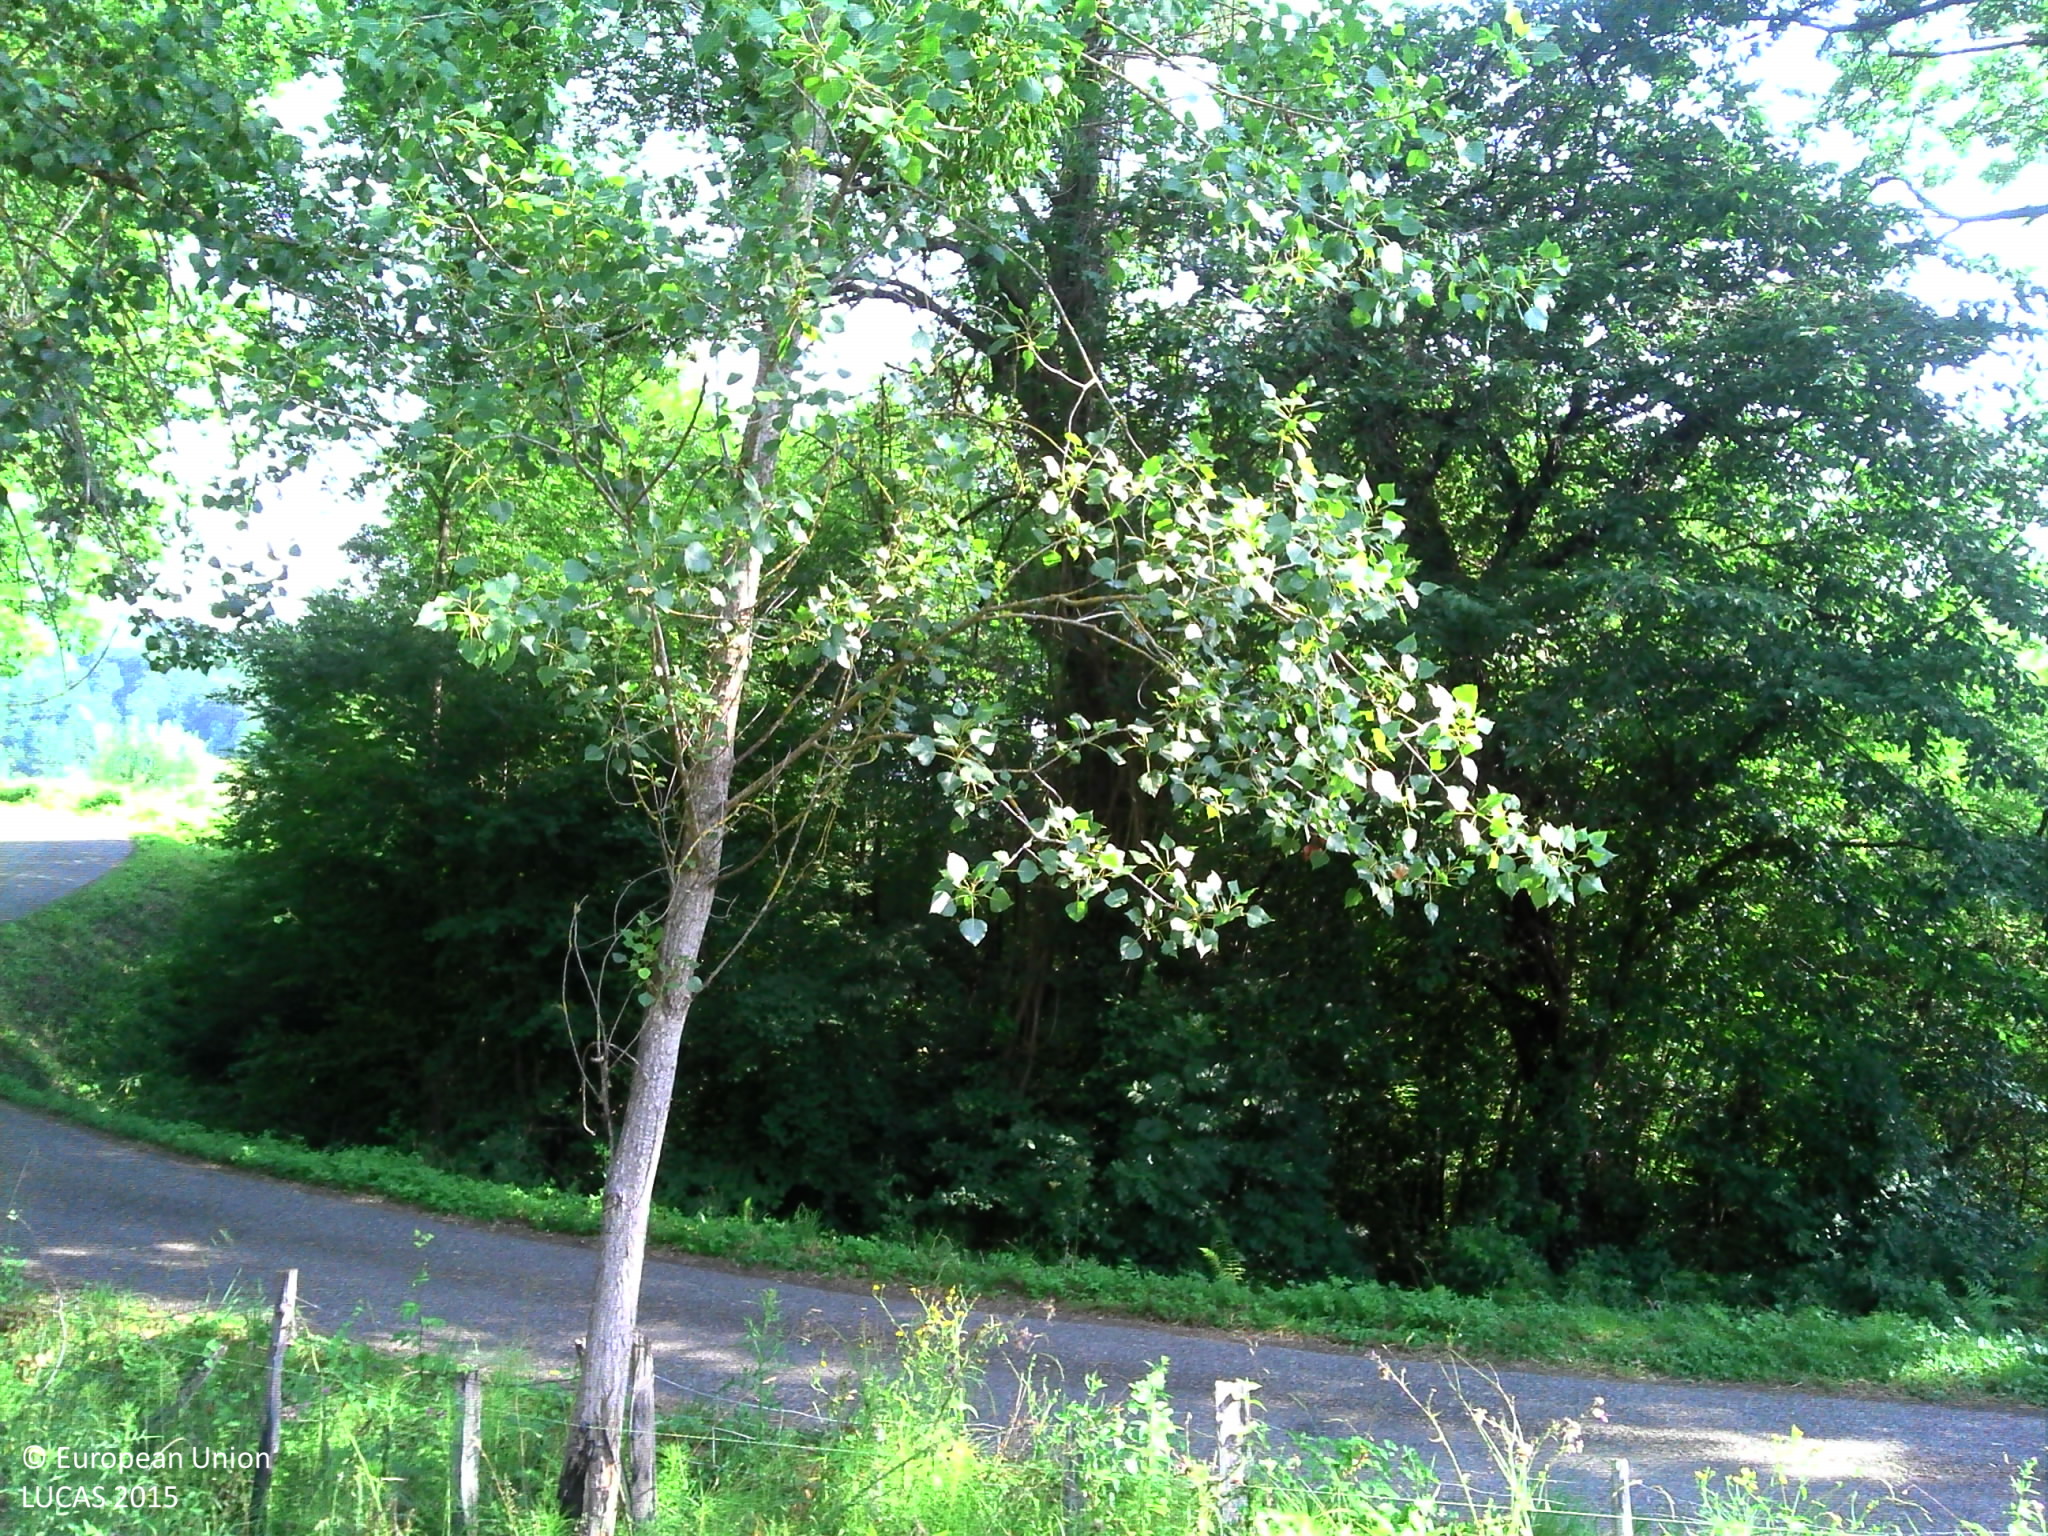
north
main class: Grassland
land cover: Spontaneously vegetated surfaces
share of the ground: > 75 %
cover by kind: herbaceous plants 100 %
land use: Agriculture (excluding fallow land and kitchen gardens)
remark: Temporary dry
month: July
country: FR
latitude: 43.0047
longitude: 1.0858
